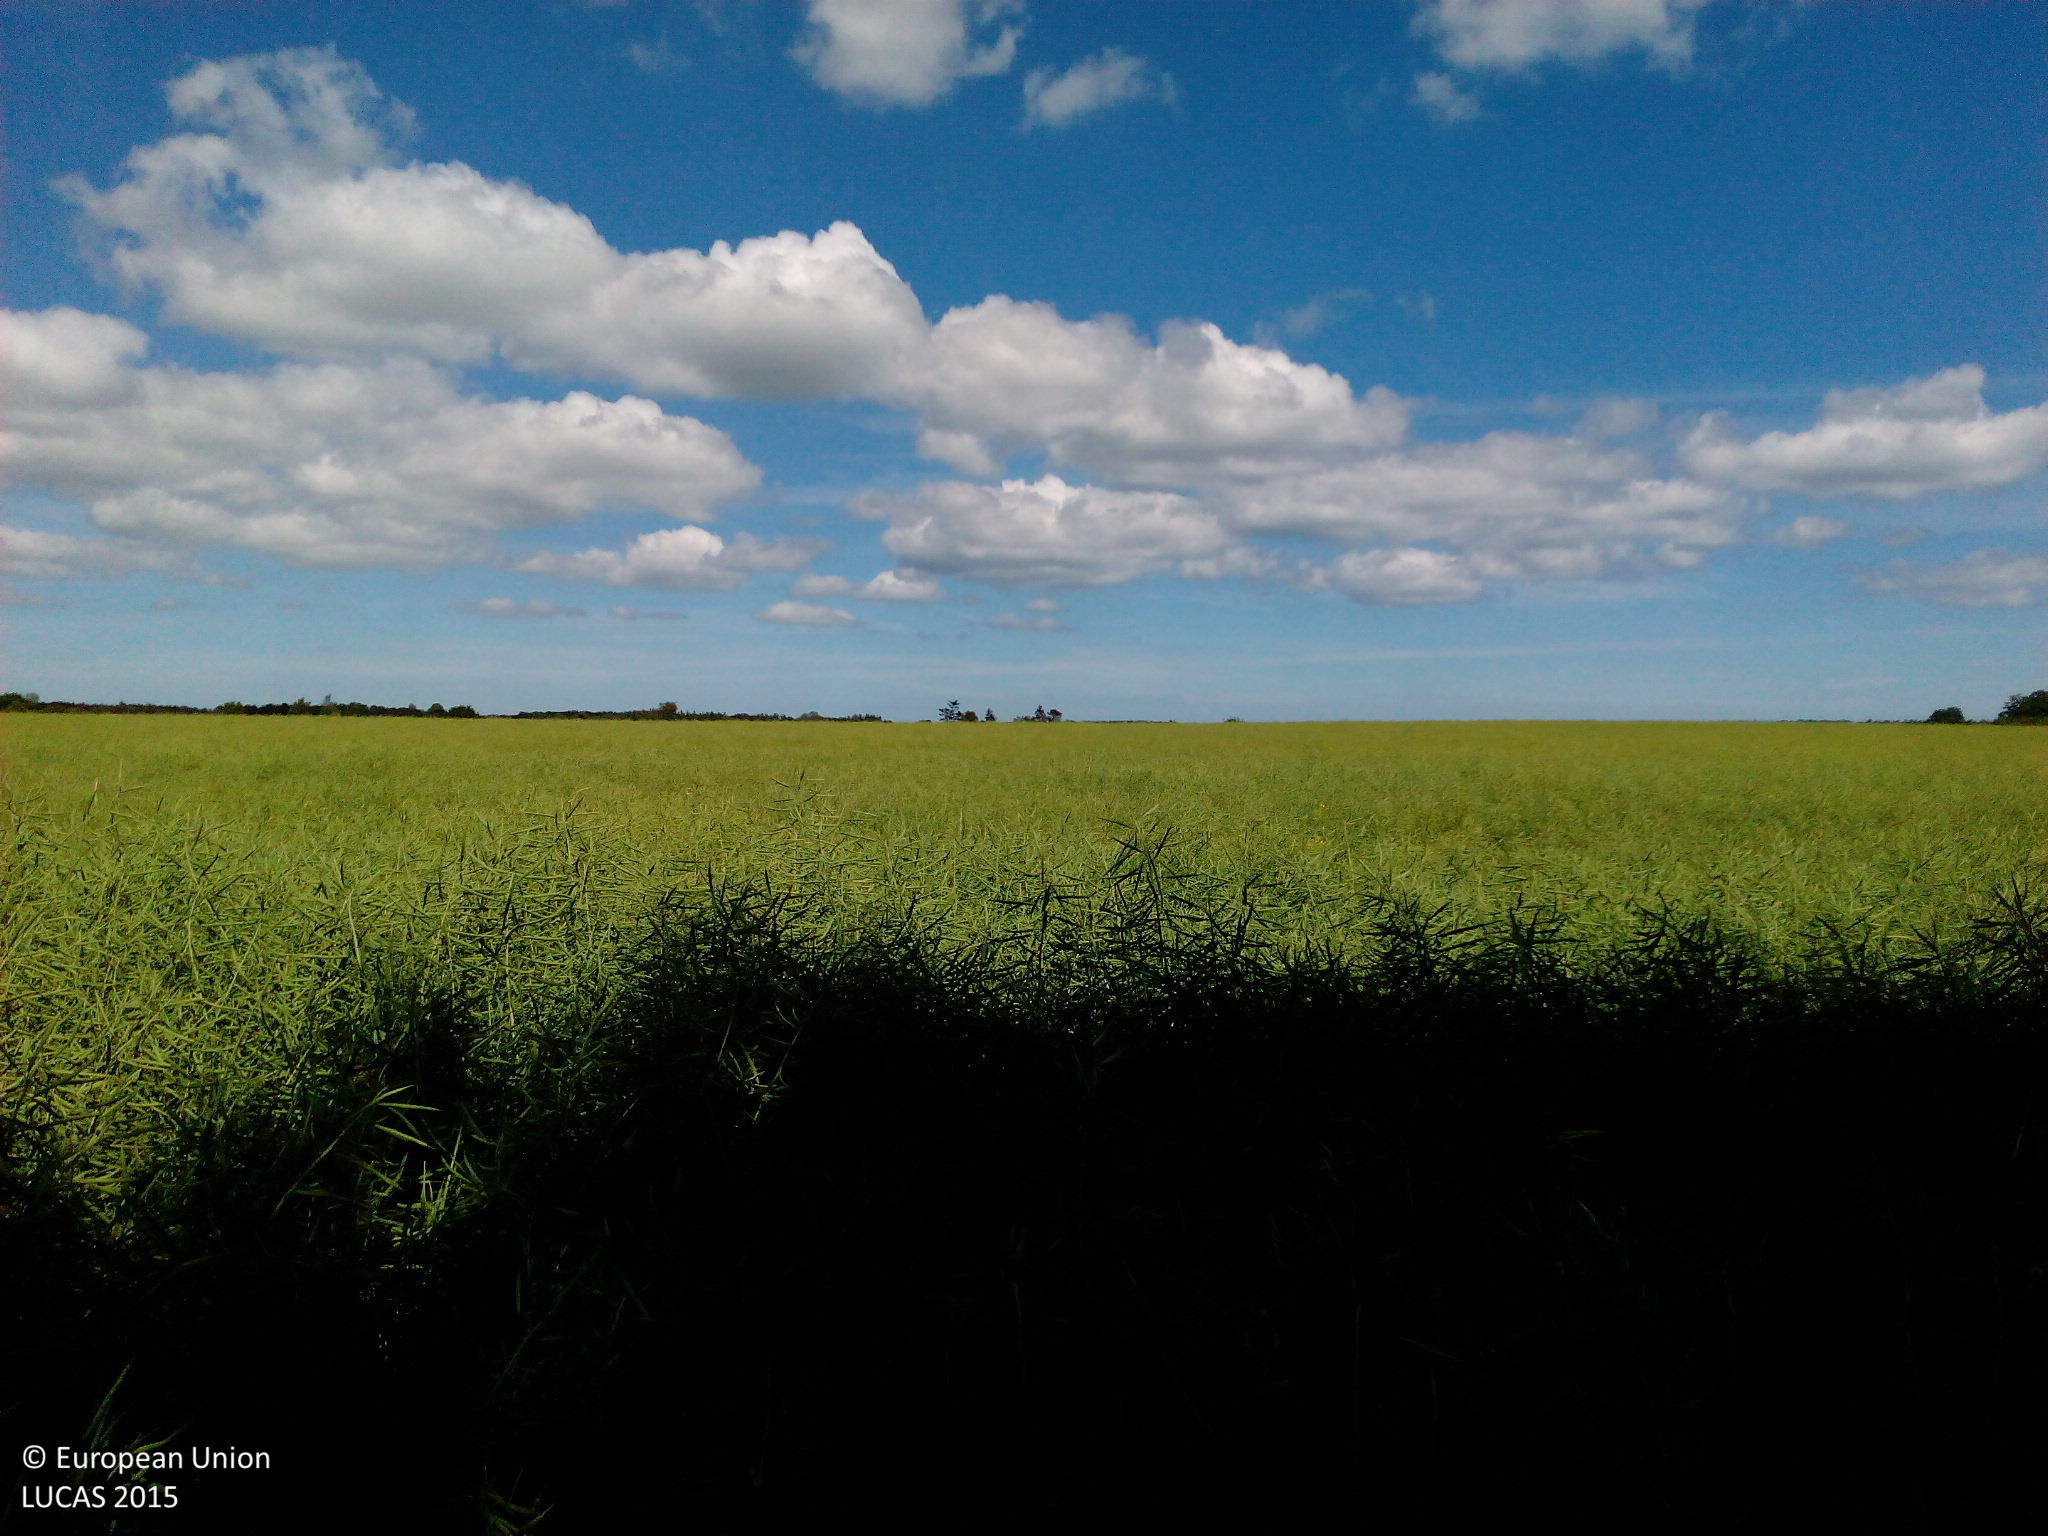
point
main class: Cropland
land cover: Rape and turnip rape
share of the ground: > 75 %
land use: Agriculture (excluding fallow land and kitchen gardens)
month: June
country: DK
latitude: 56.3109
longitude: 10.8234
